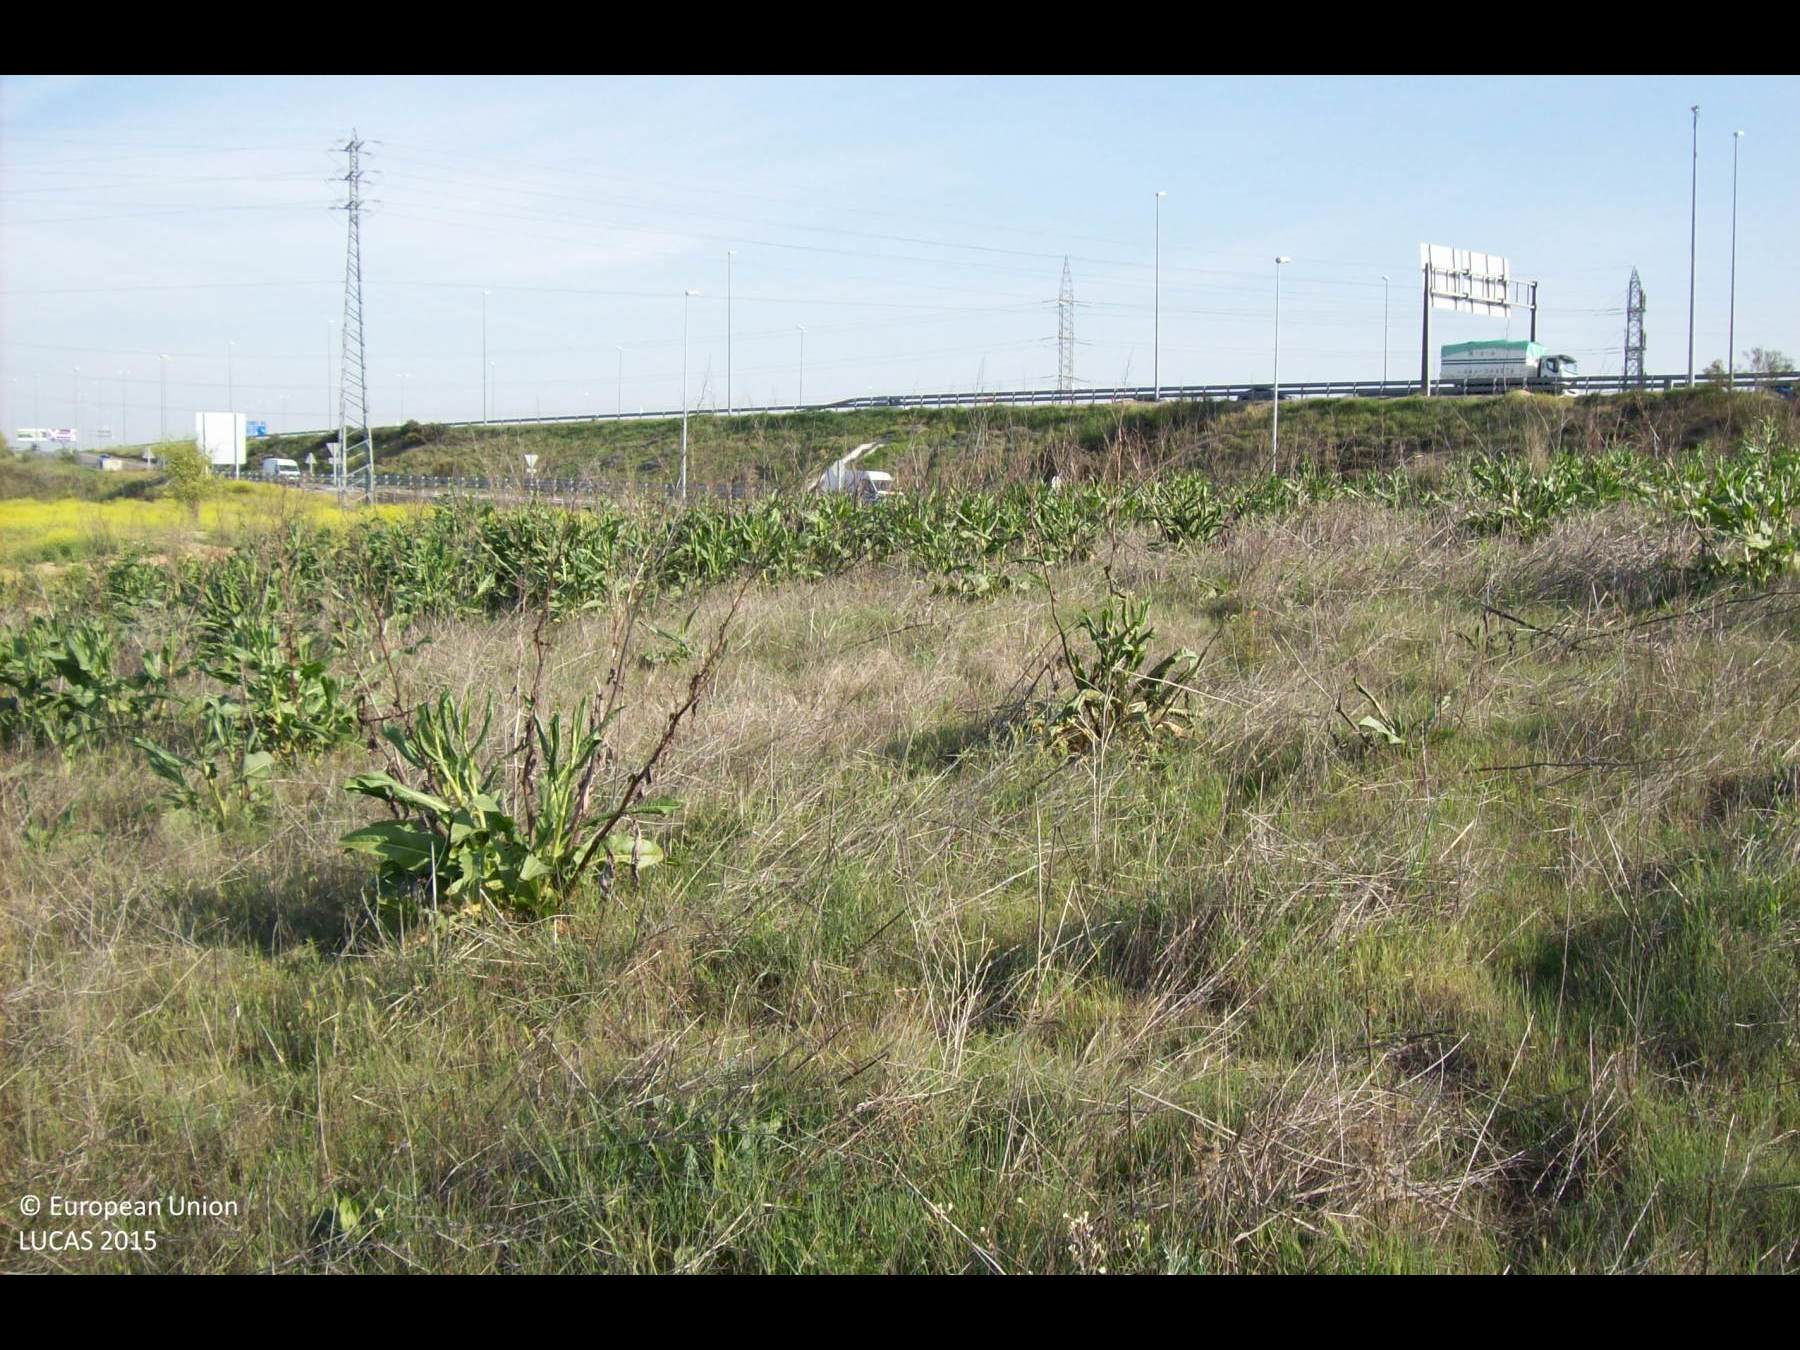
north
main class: Grassland
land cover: Spontaneously vegetated surfaces
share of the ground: > 75 %
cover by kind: herbaceous plants 80 %
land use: Abandoned areas
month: April
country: ES
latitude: 40.3252
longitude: -3.8436
